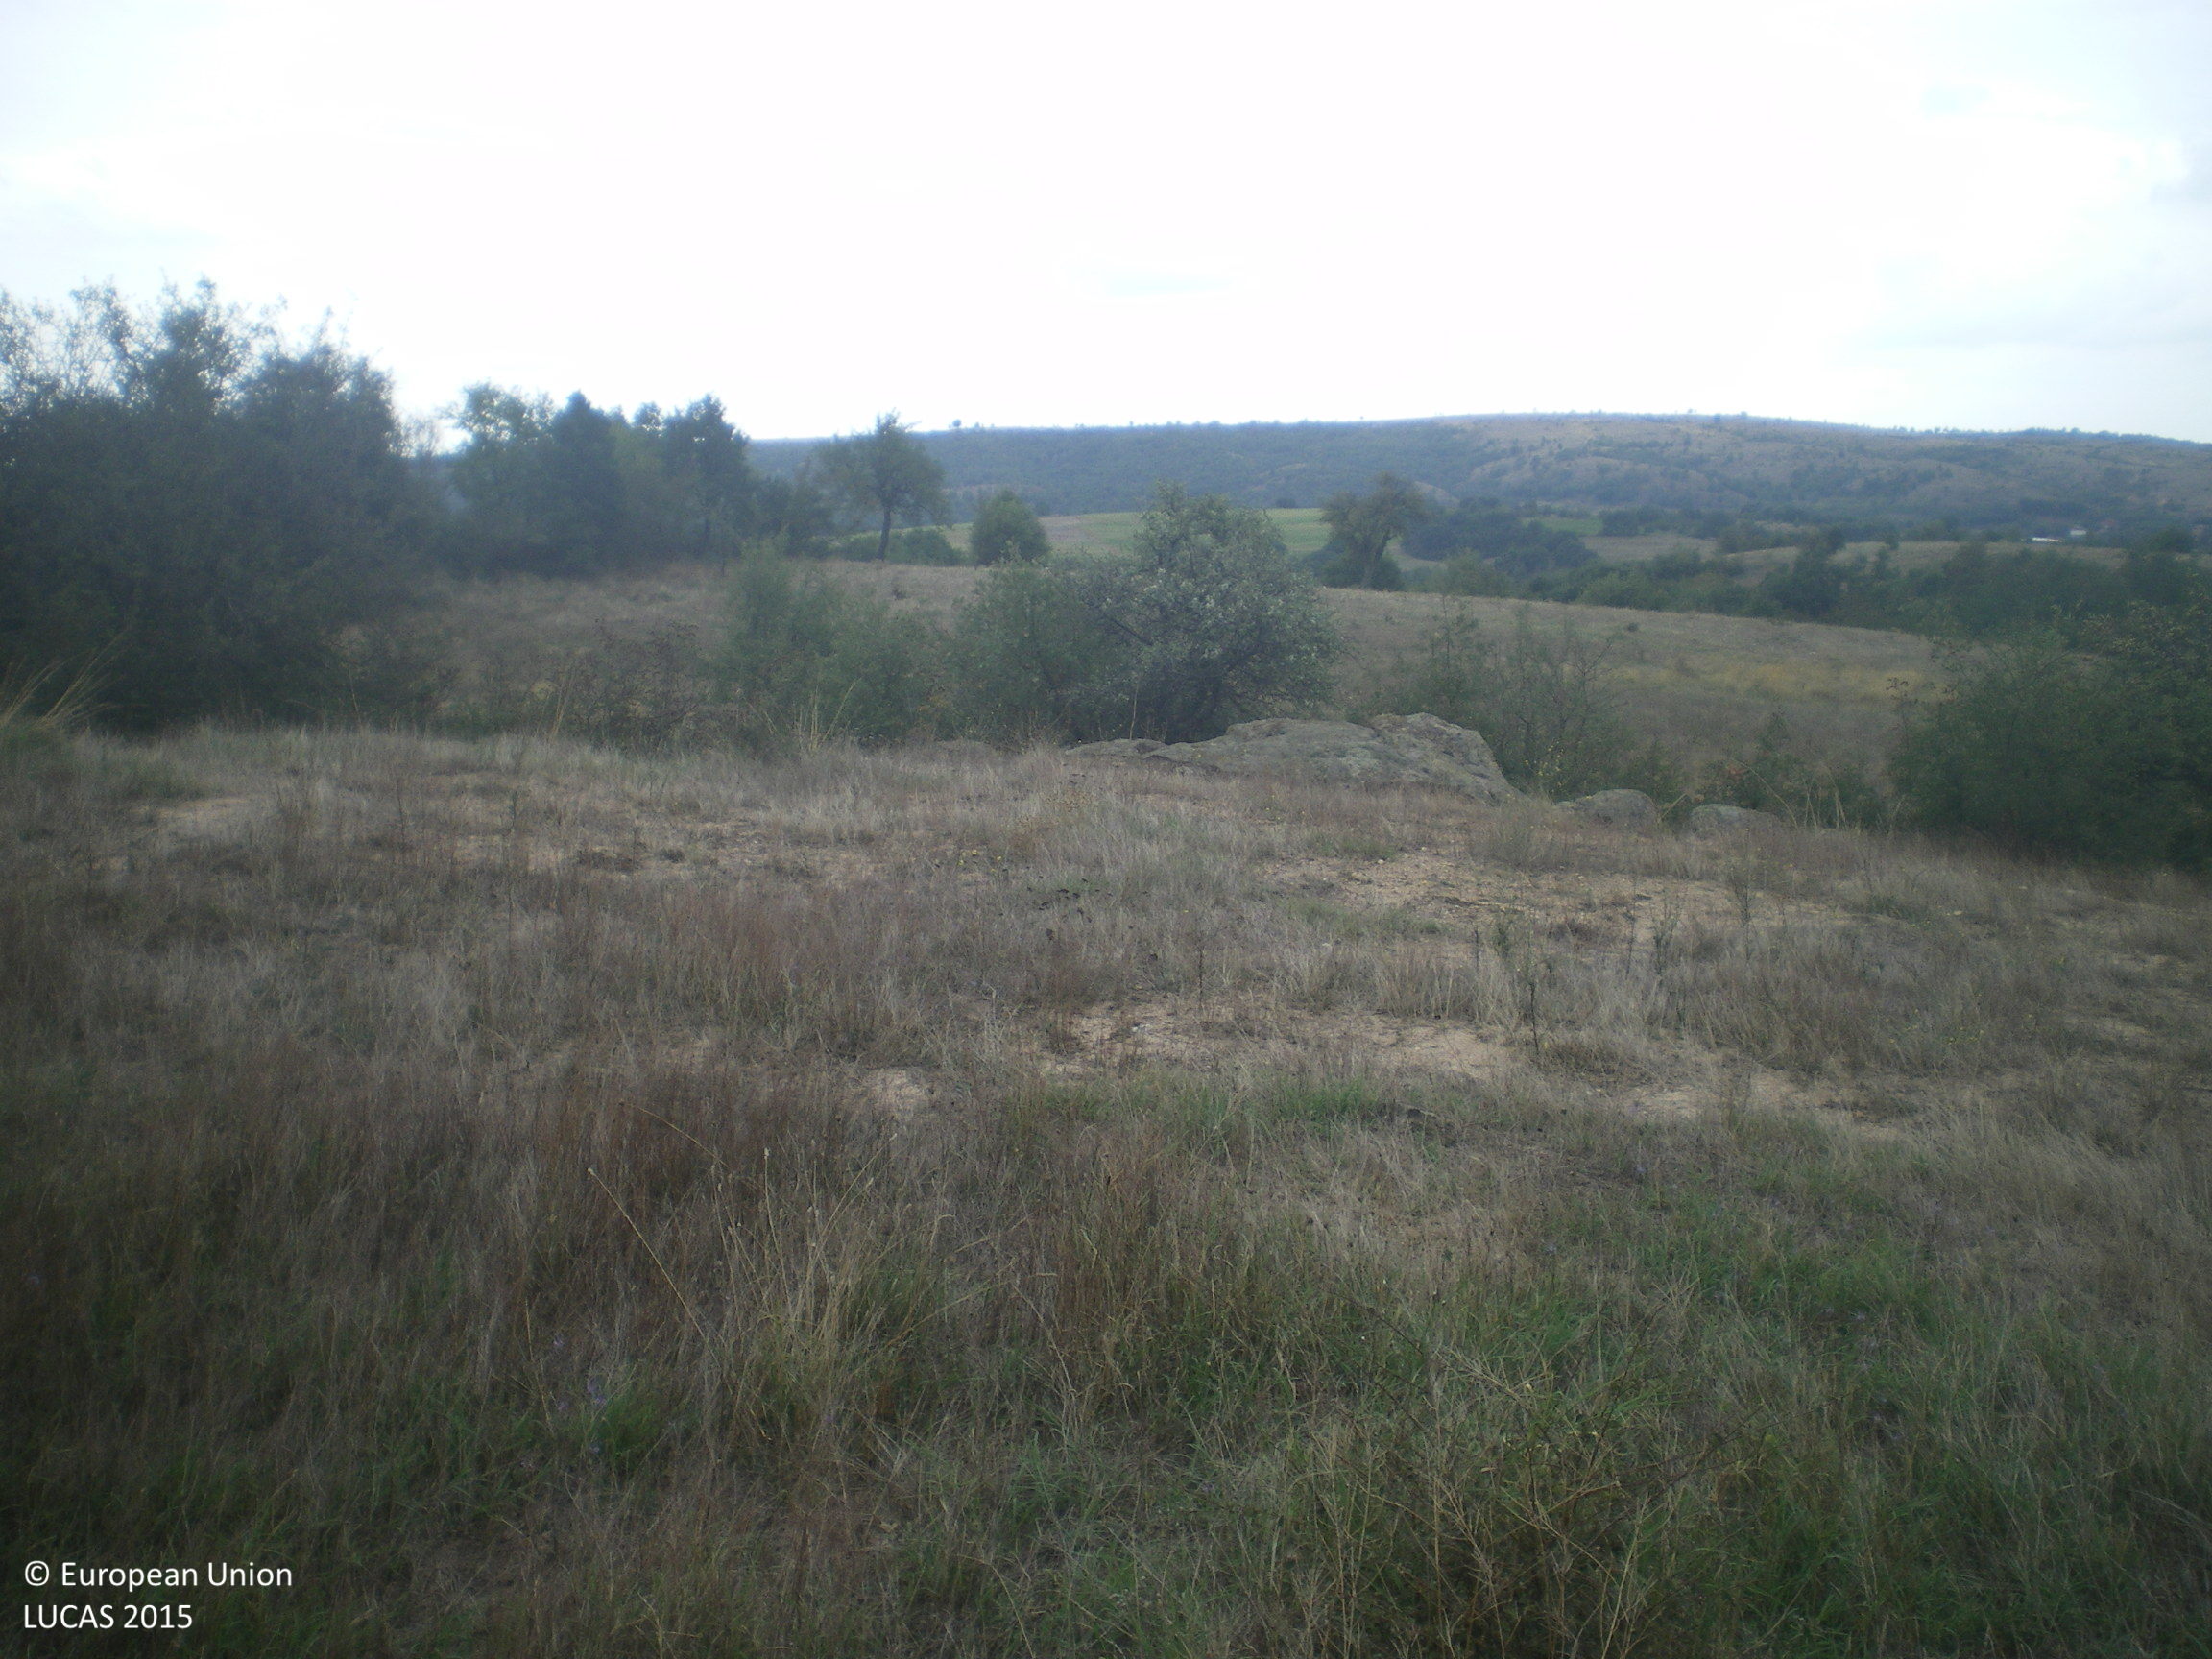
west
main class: Grassland
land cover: Grassland with sparse tree/shrub cover
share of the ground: > 75 %
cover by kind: herbaceous plants 95 %, broadleaved forest trees 5 %
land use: Semi-natural and natural areas not in use
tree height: > 5 m
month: September
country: BG
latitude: 41.9662
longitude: 25.9647
